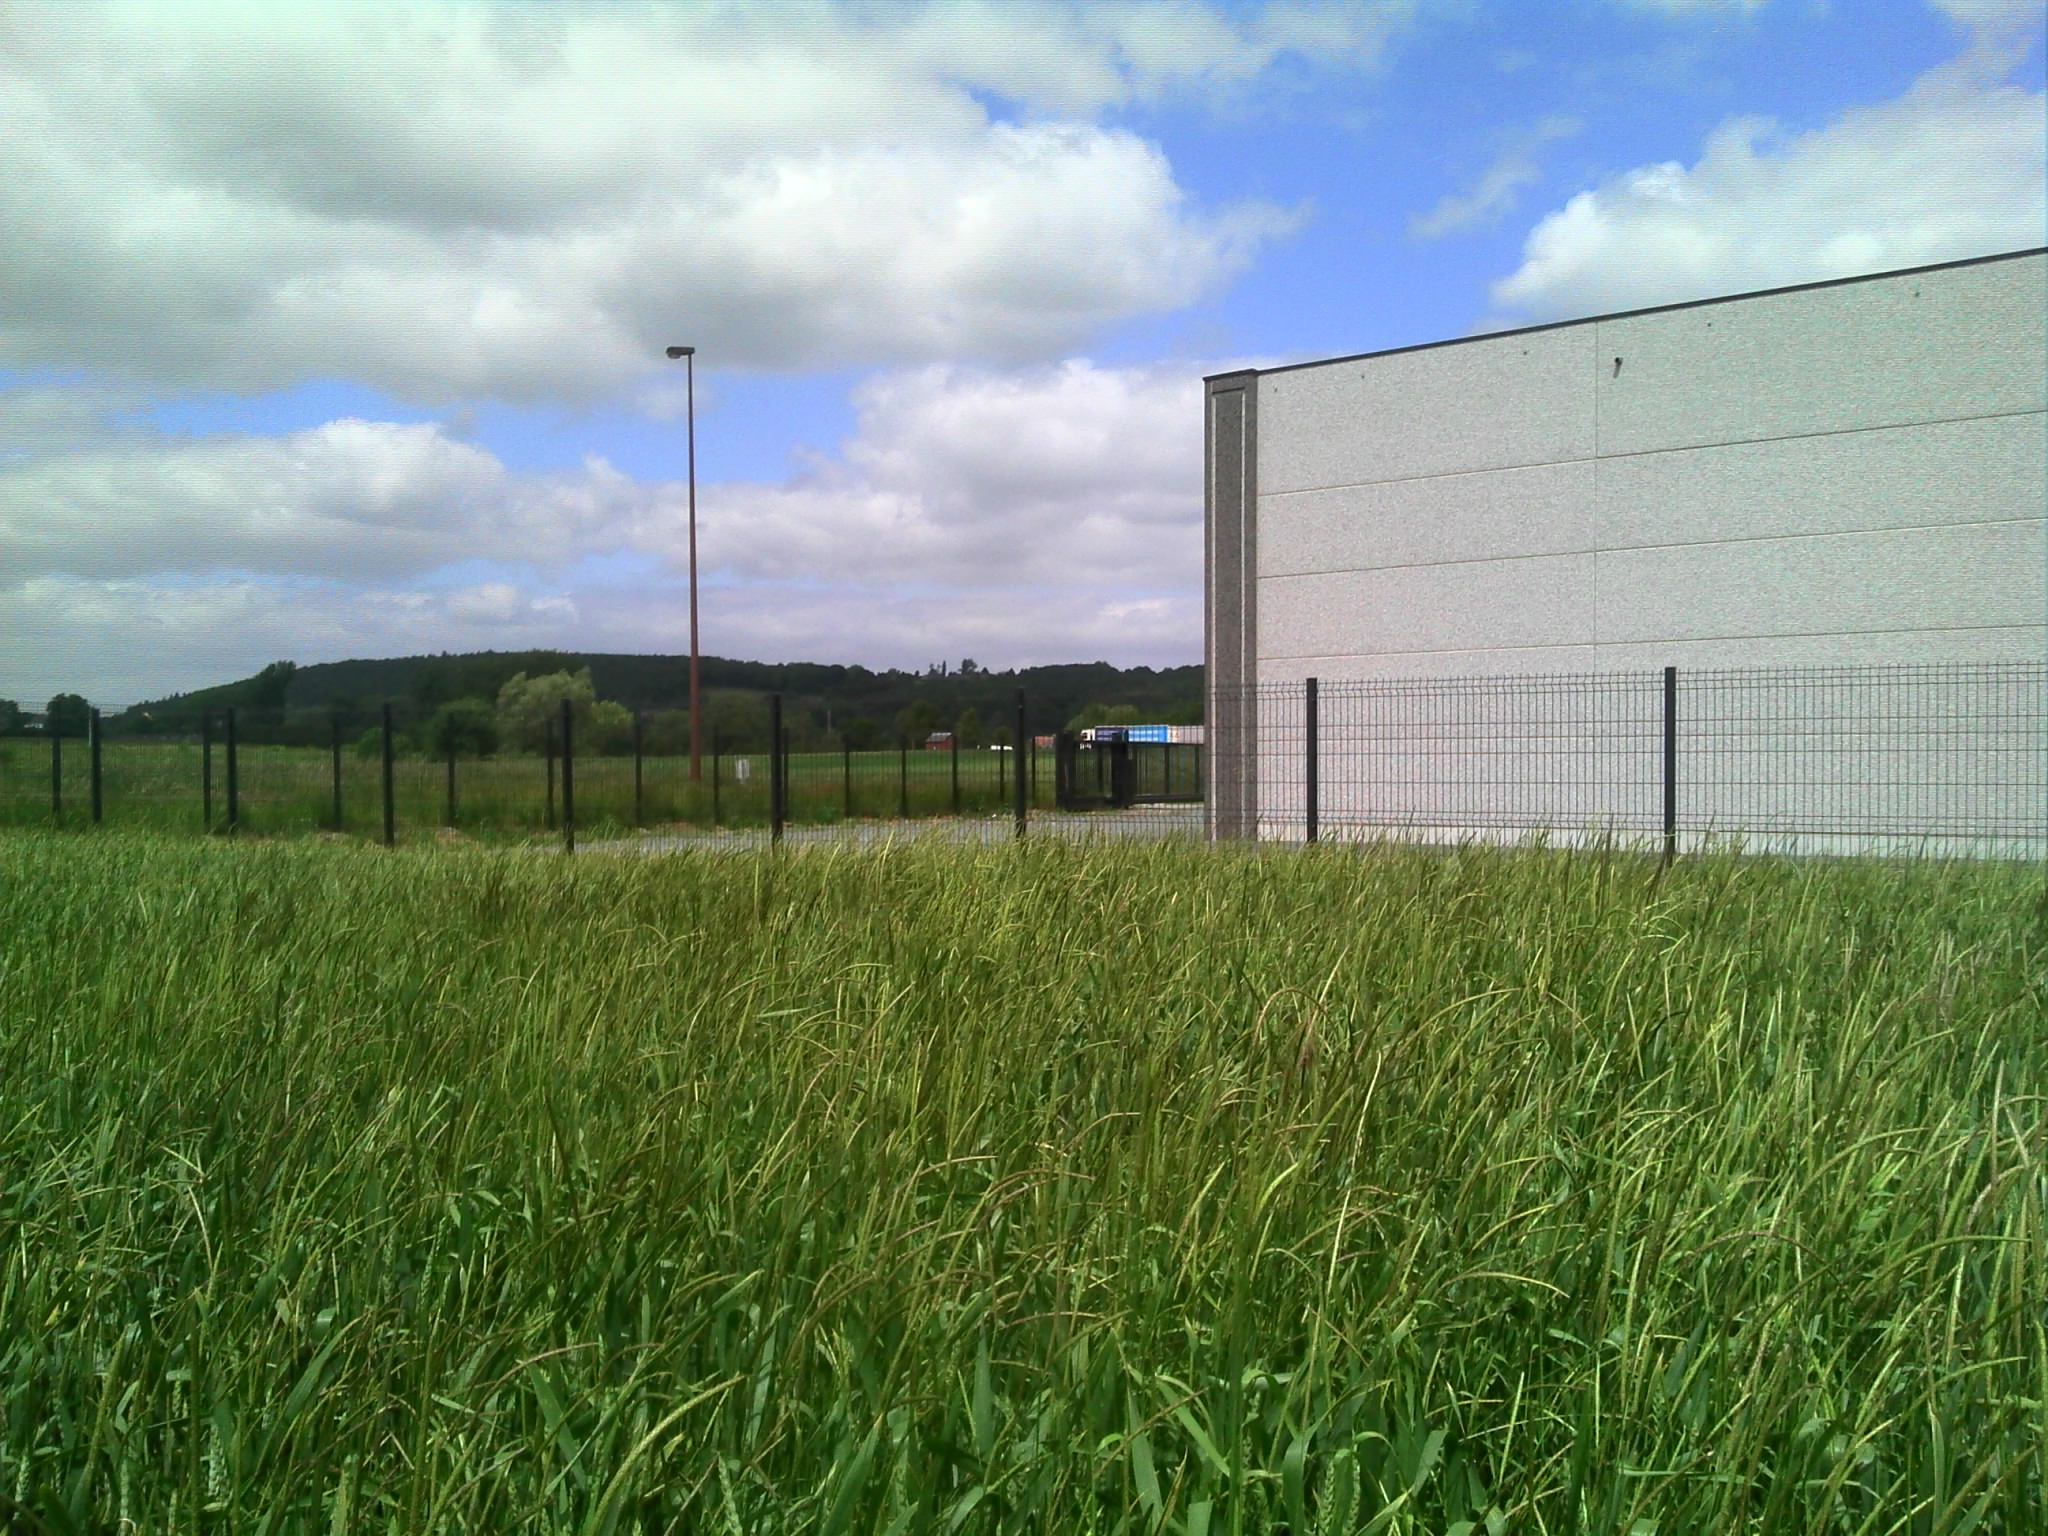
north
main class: Cropland
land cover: Common wheat
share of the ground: > 75 %
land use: Agriculture (excluding fallow land and kitchen gardens)
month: June
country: BE
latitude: 50.4581
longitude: 4.7143
